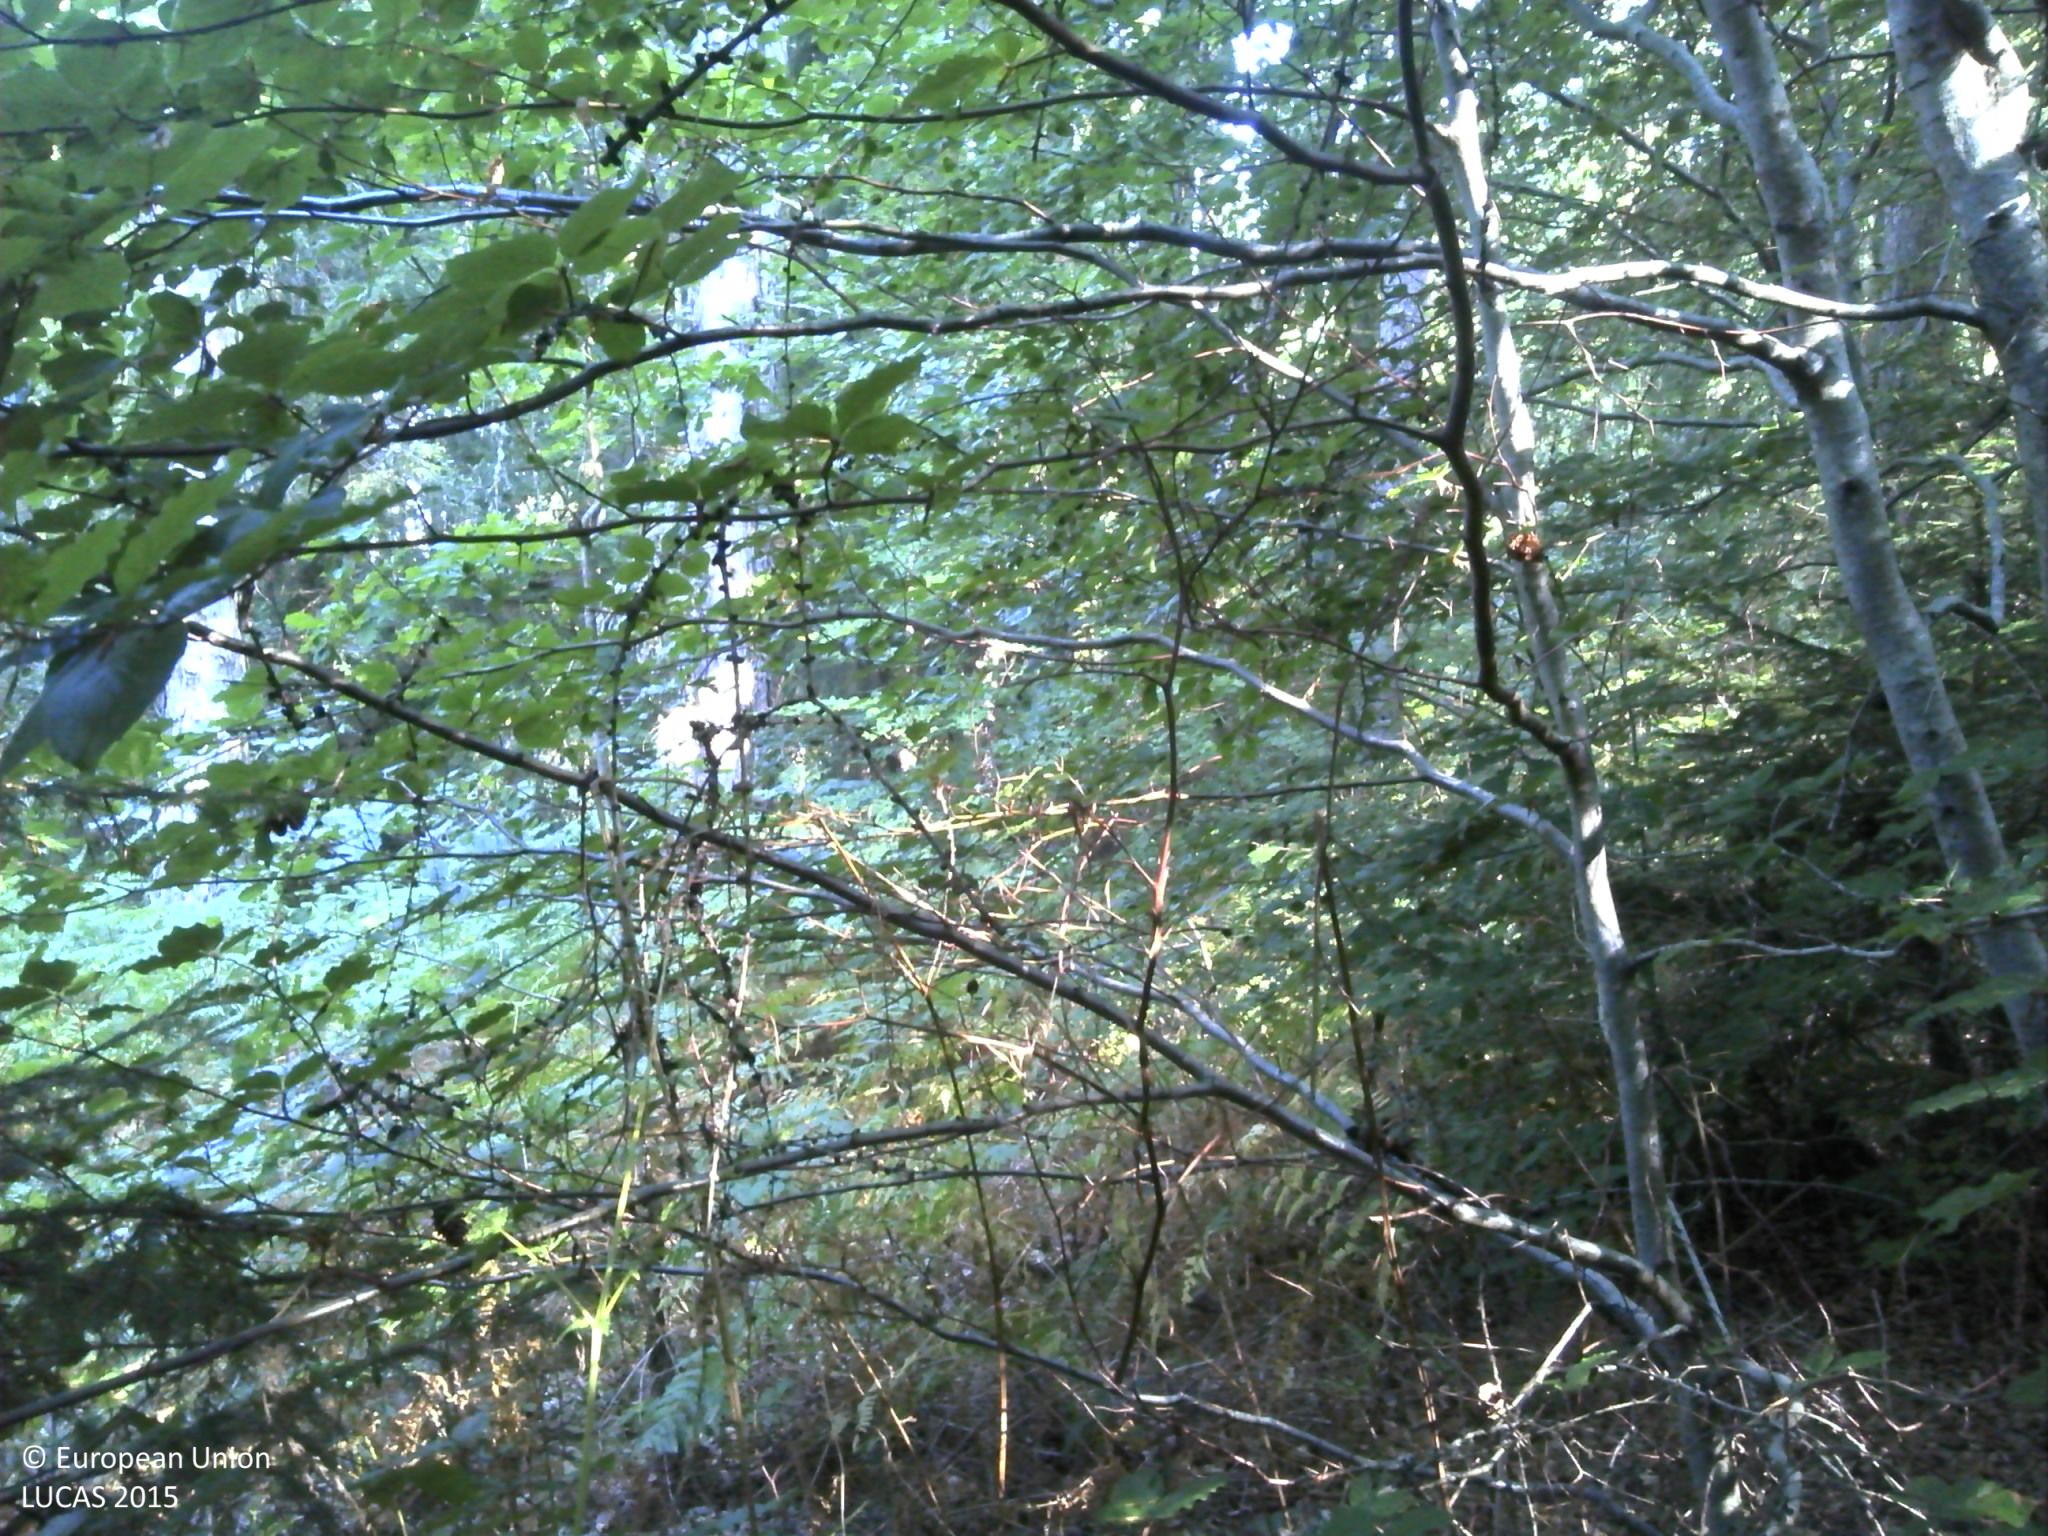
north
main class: Woodland
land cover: Other mixed woodland
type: mountainous beech forest
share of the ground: > 75 %
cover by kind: broadleaved forest trees 40 %, coniferous forest trees 30 %, unconsolidated bare surface 20 %, herbaceous plants 5 %, lichens and mosses 5 %
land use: Forestry
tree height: > 5 m
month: August
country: FR
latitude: 45.4665
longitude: 2.4138
